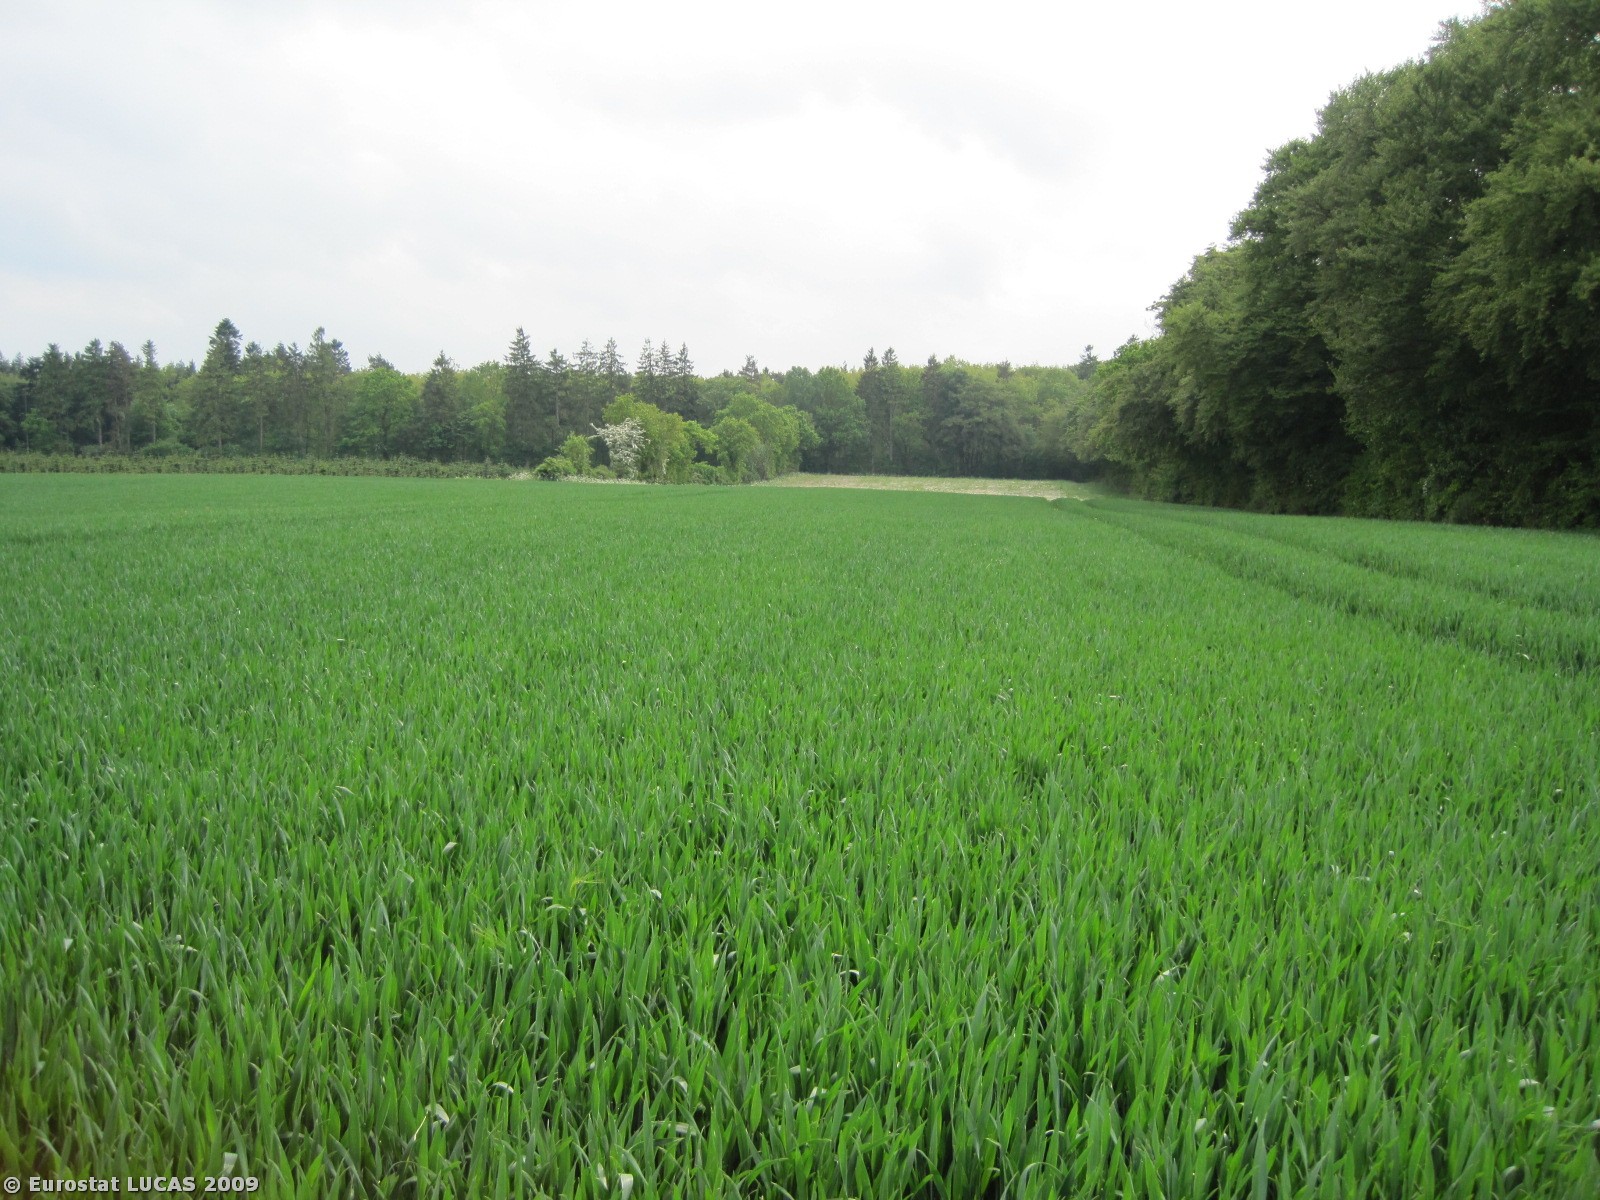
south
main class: Cropland
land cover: Common wheat
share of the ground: 50 - 75 %
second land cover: Oats
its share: 10 - 25 %
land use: Agriculture (excluding fallow land and kitchen gardens)
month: May
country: DK
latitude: 56.4572
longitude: 9.7893
